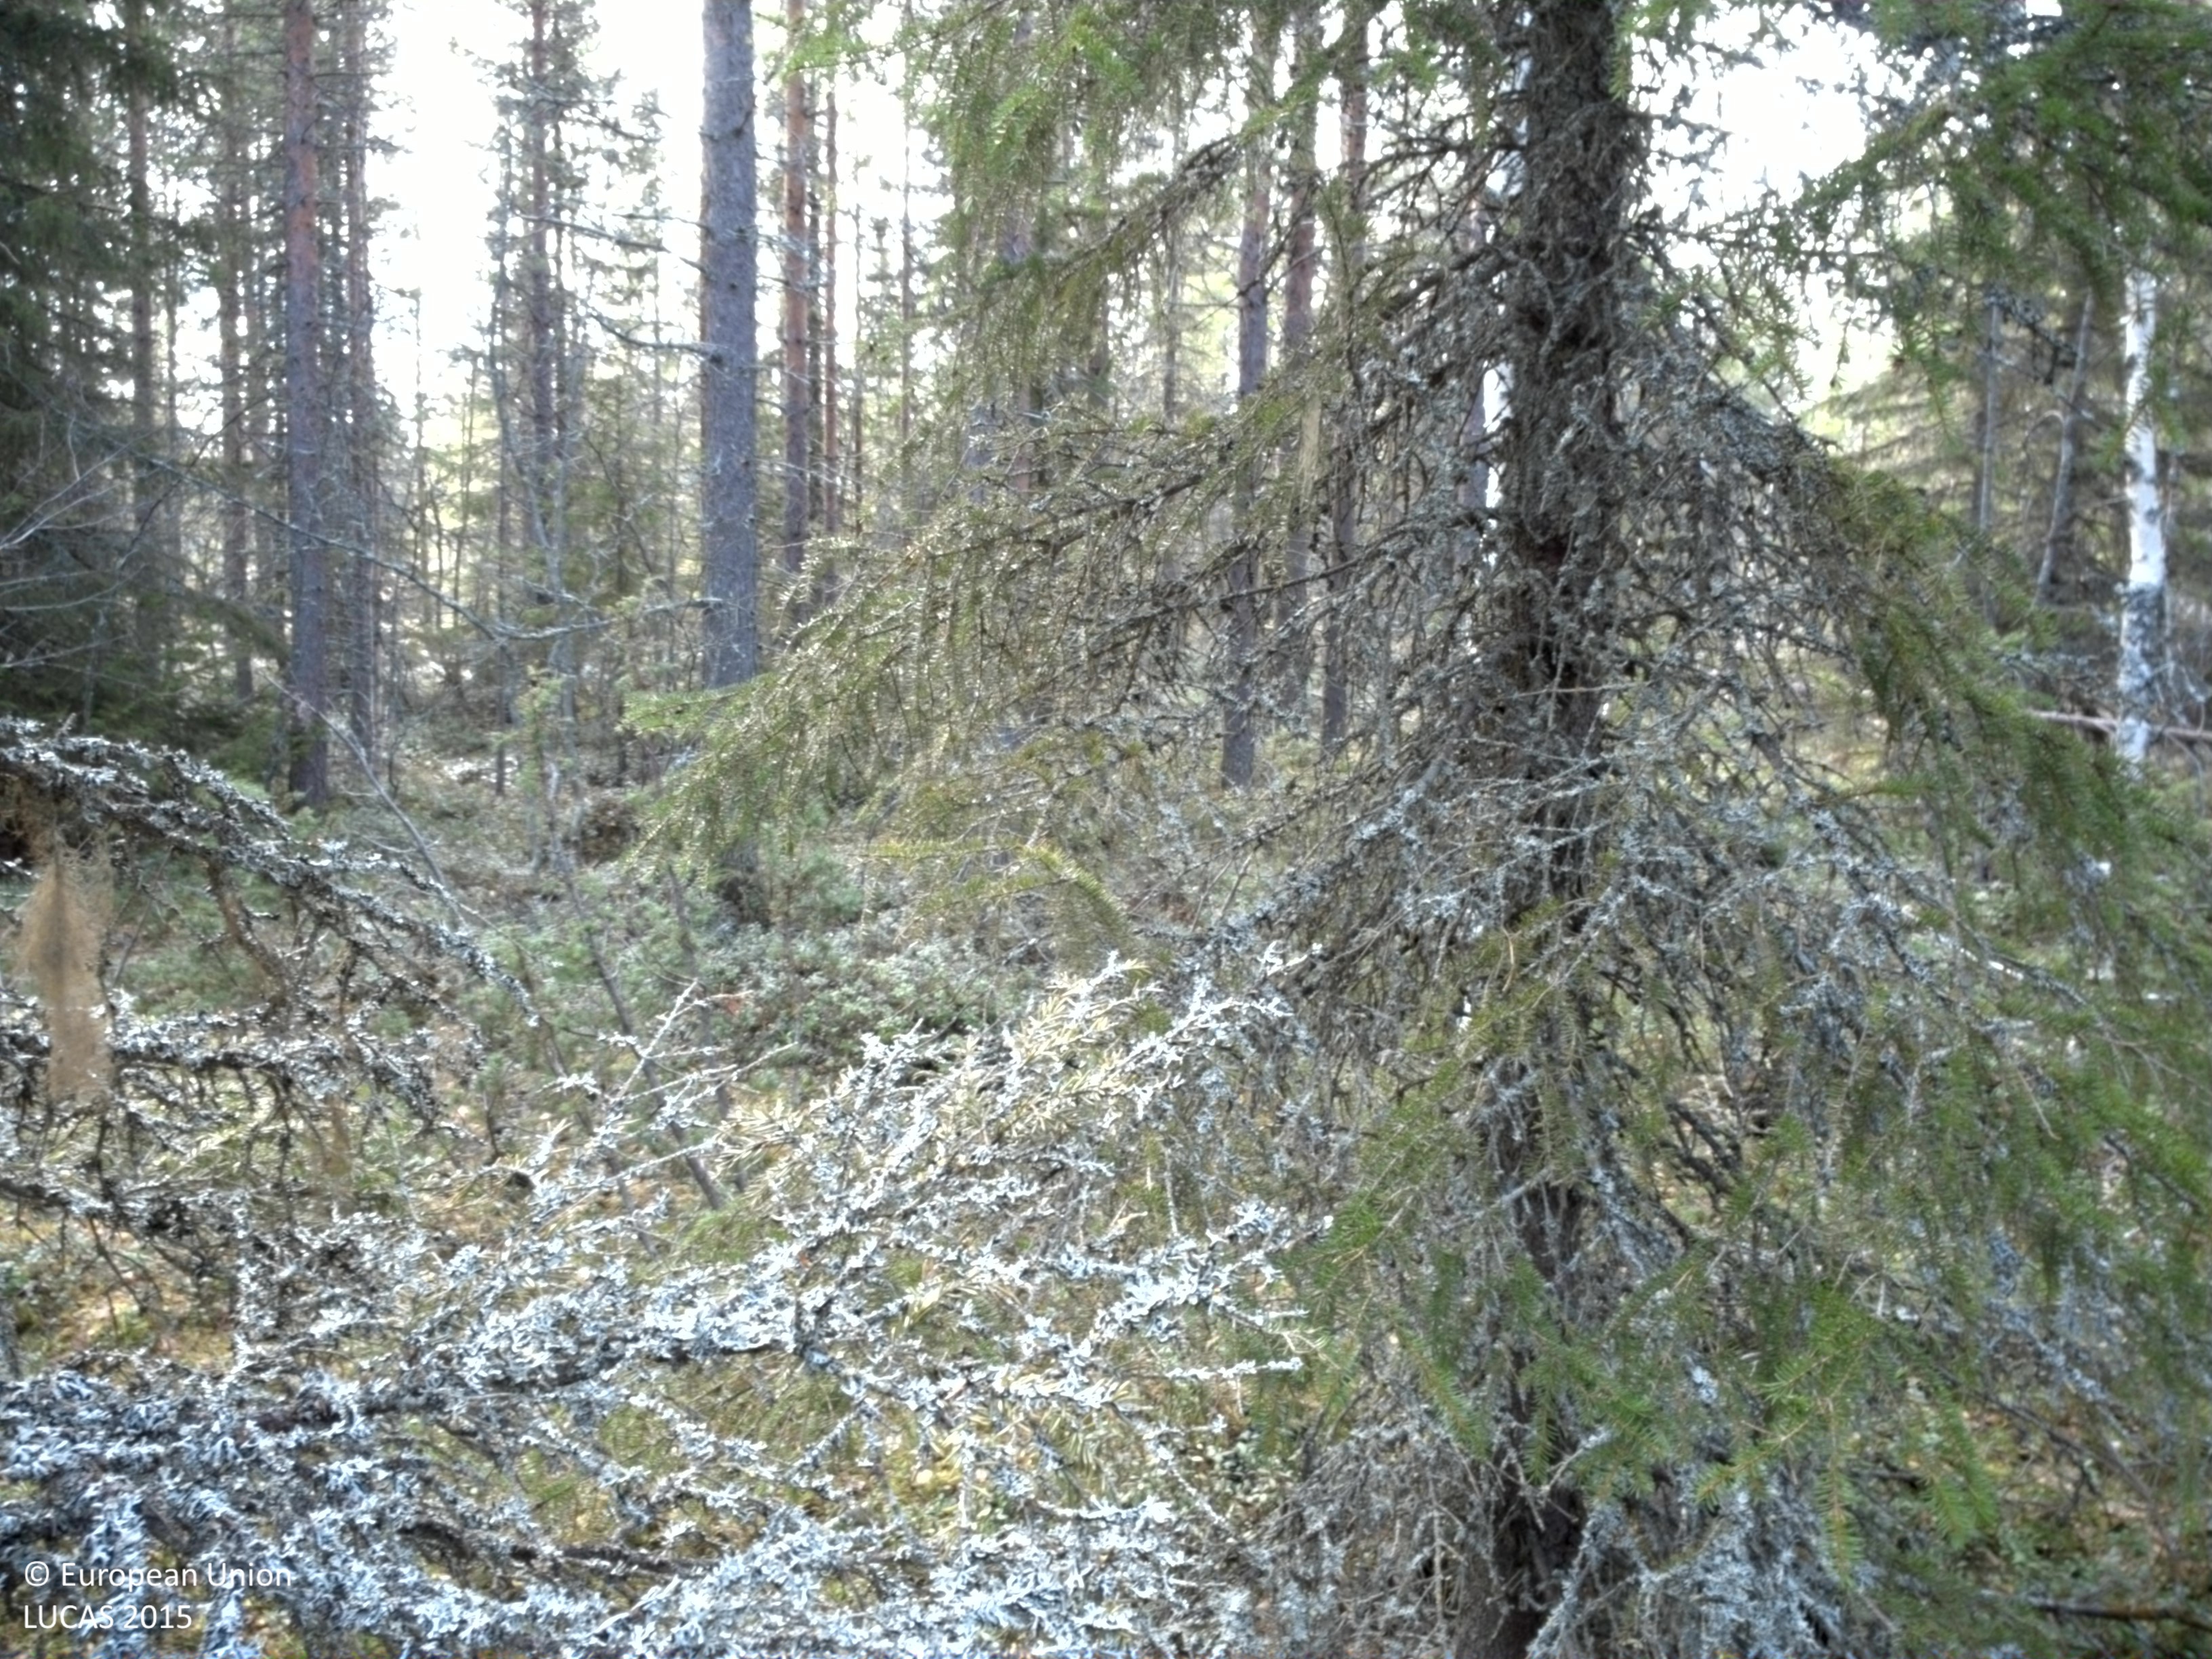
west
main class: Woodland
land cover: Pine dominated coniferous woodland
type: boreal forest
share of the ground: > 75 %
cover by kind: coniferous forest trees 80 %, shrubs 10 %, broadleaved forest trees 5 %, lichens and mosses 5 %
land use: Forestry
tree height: > 5 m
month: May
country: SE
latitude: 65.7416
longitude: 23.1426
